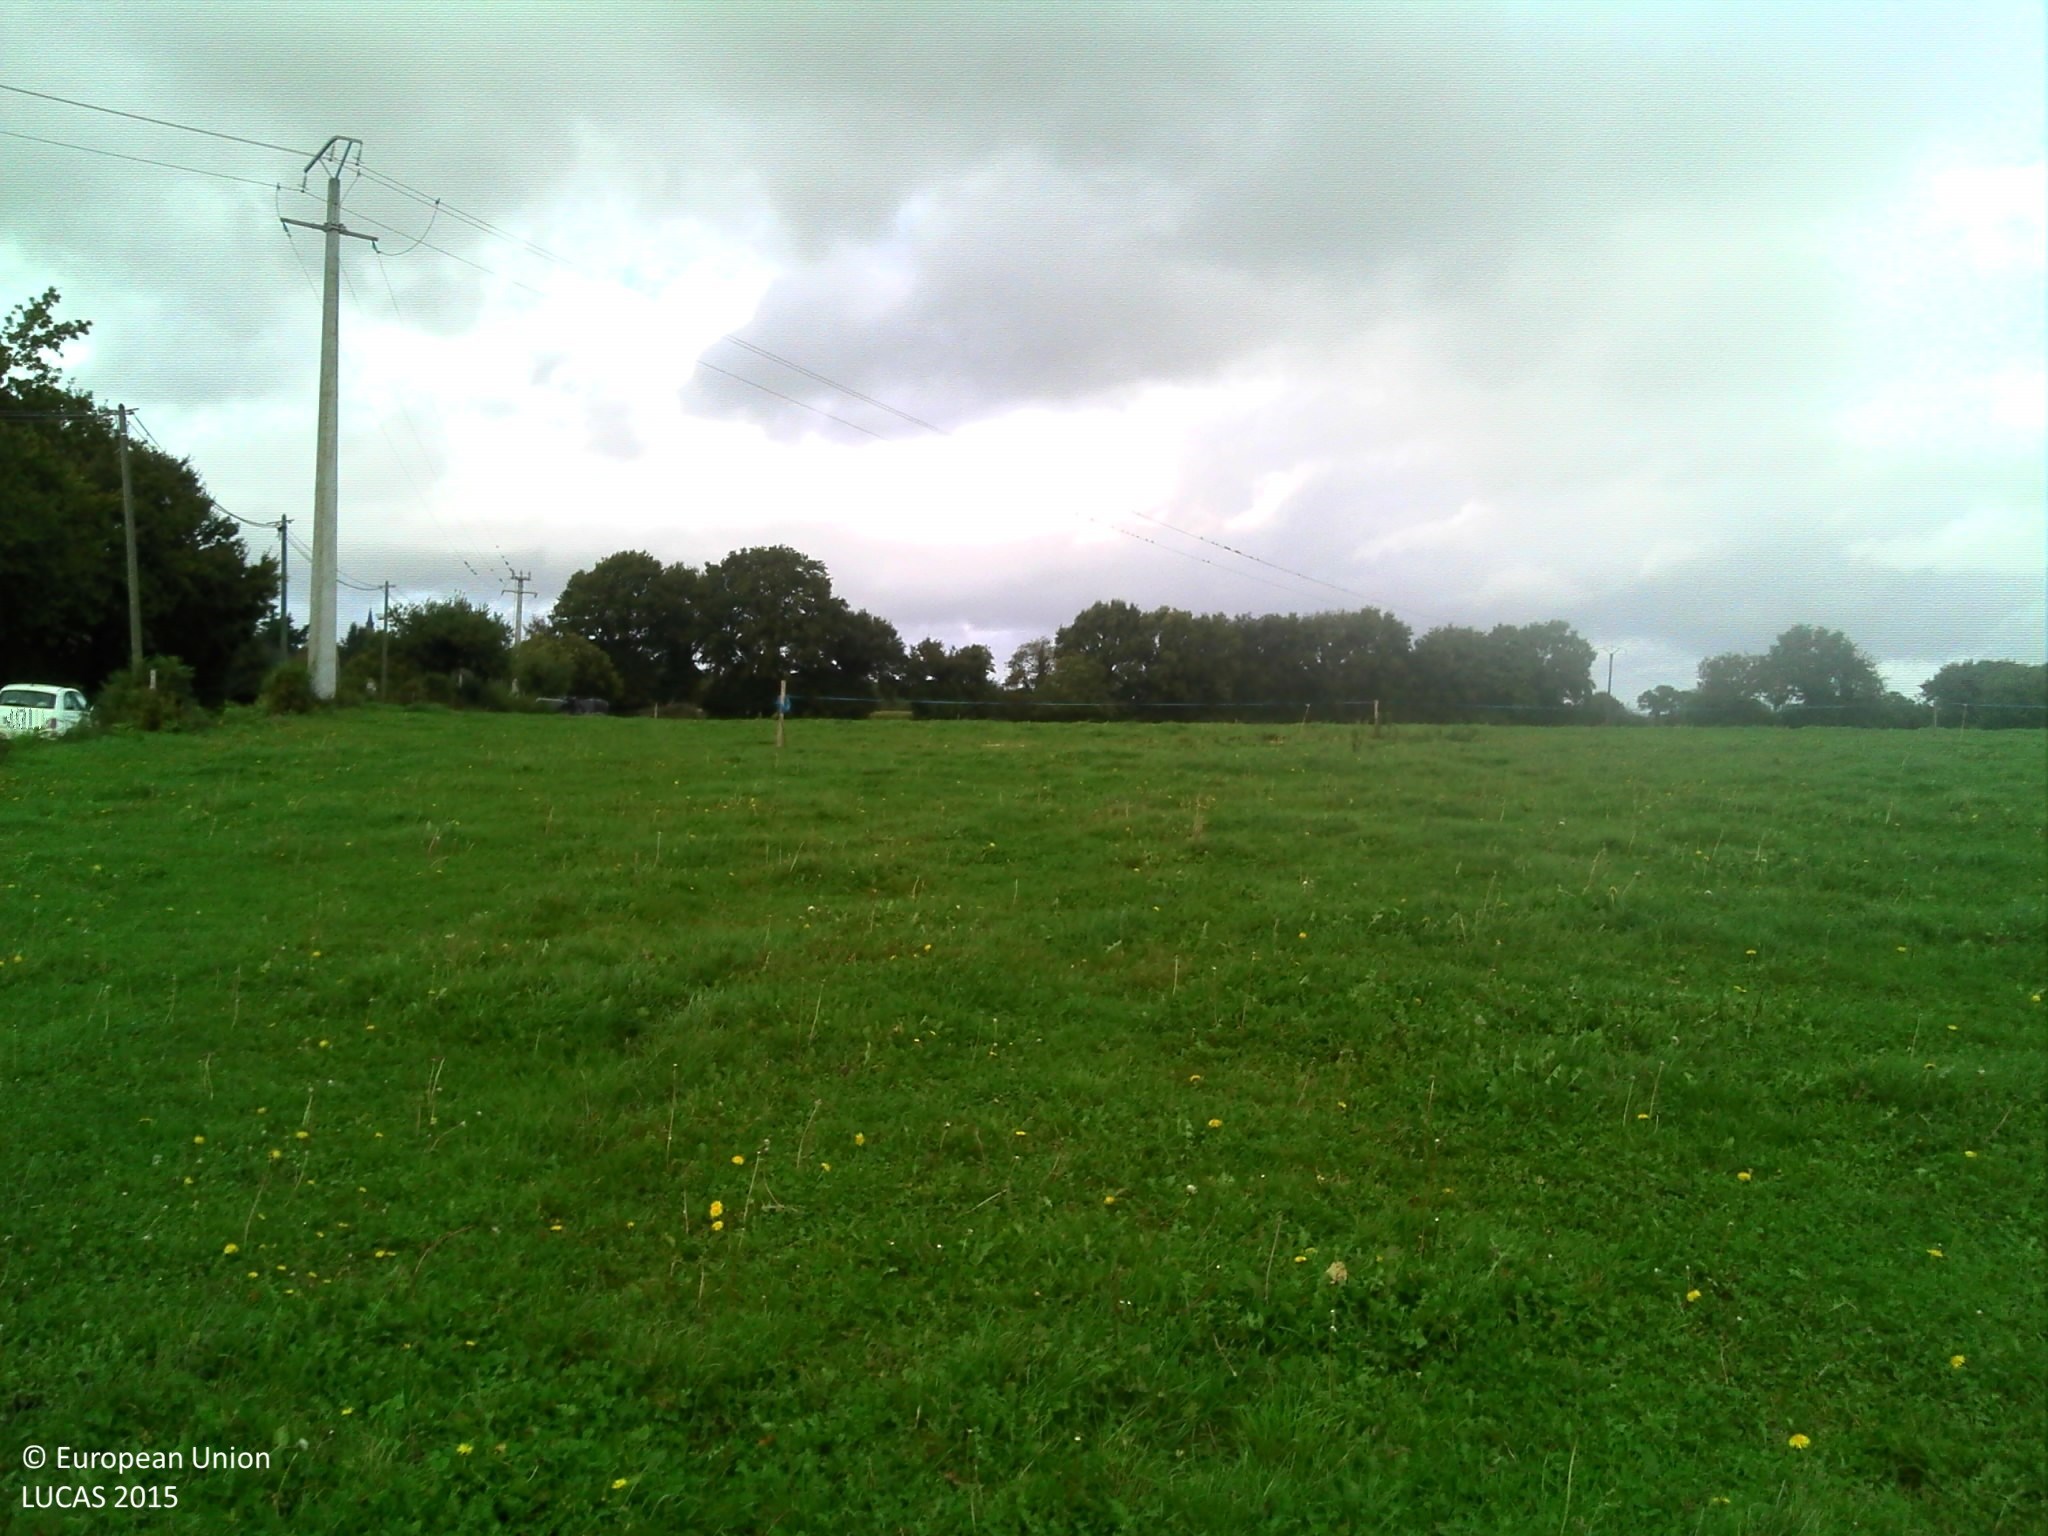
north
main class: Grassland
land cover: Grassland without tree/shrub cover
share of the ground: > 75 %
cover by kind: herbaceous plants 100 %
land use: Agriculture (excluding fallow land and kitchen gardens)
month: October
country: FR
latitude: 47.7959
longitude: -2.2162
